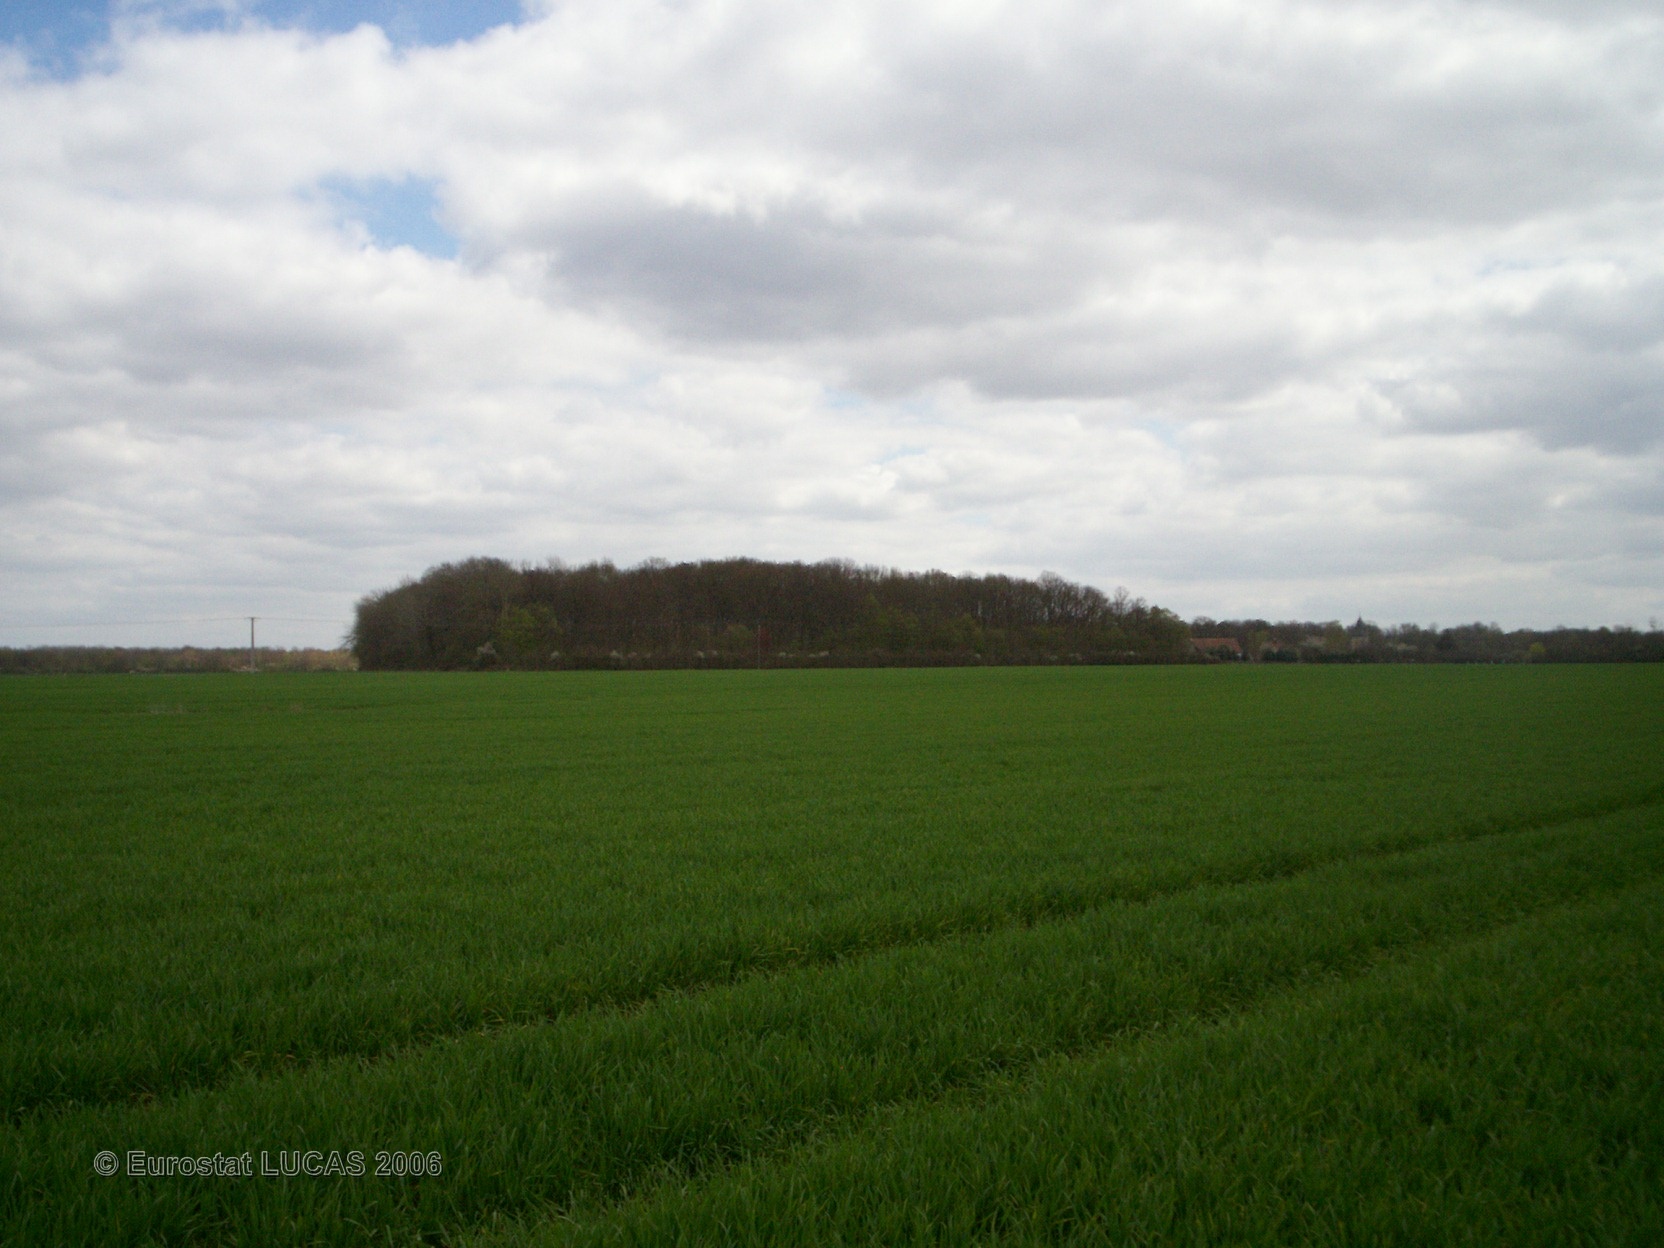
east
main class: Cropland
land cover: Common wheat
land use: Agriculture (excluding fallow land and kitchen gardens)
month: April
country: FR
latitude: 48.4976
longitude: 2.8593
